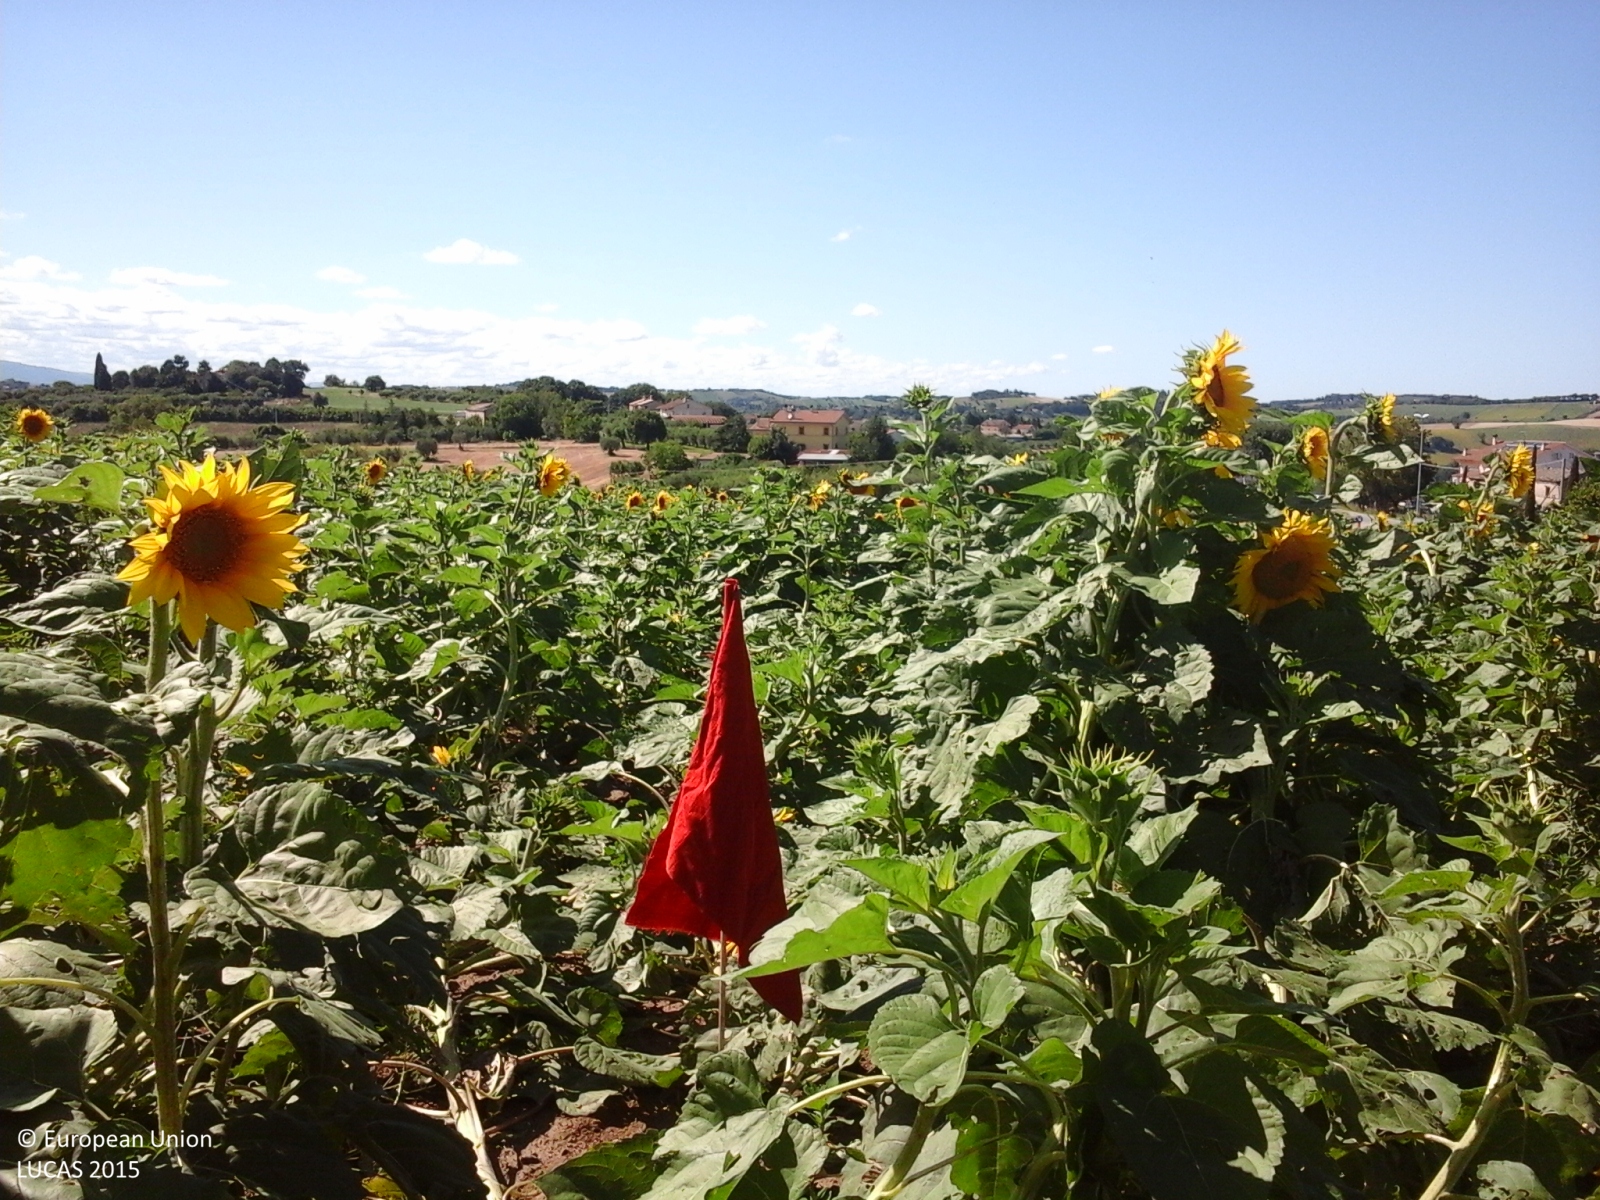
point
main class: Cropland
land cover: Sunflower
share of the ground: > 75 %
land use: Agriculture (excluding fallow land and kitchen gardens)
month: June
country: IT
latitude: 43.2982
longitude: 13.5041
